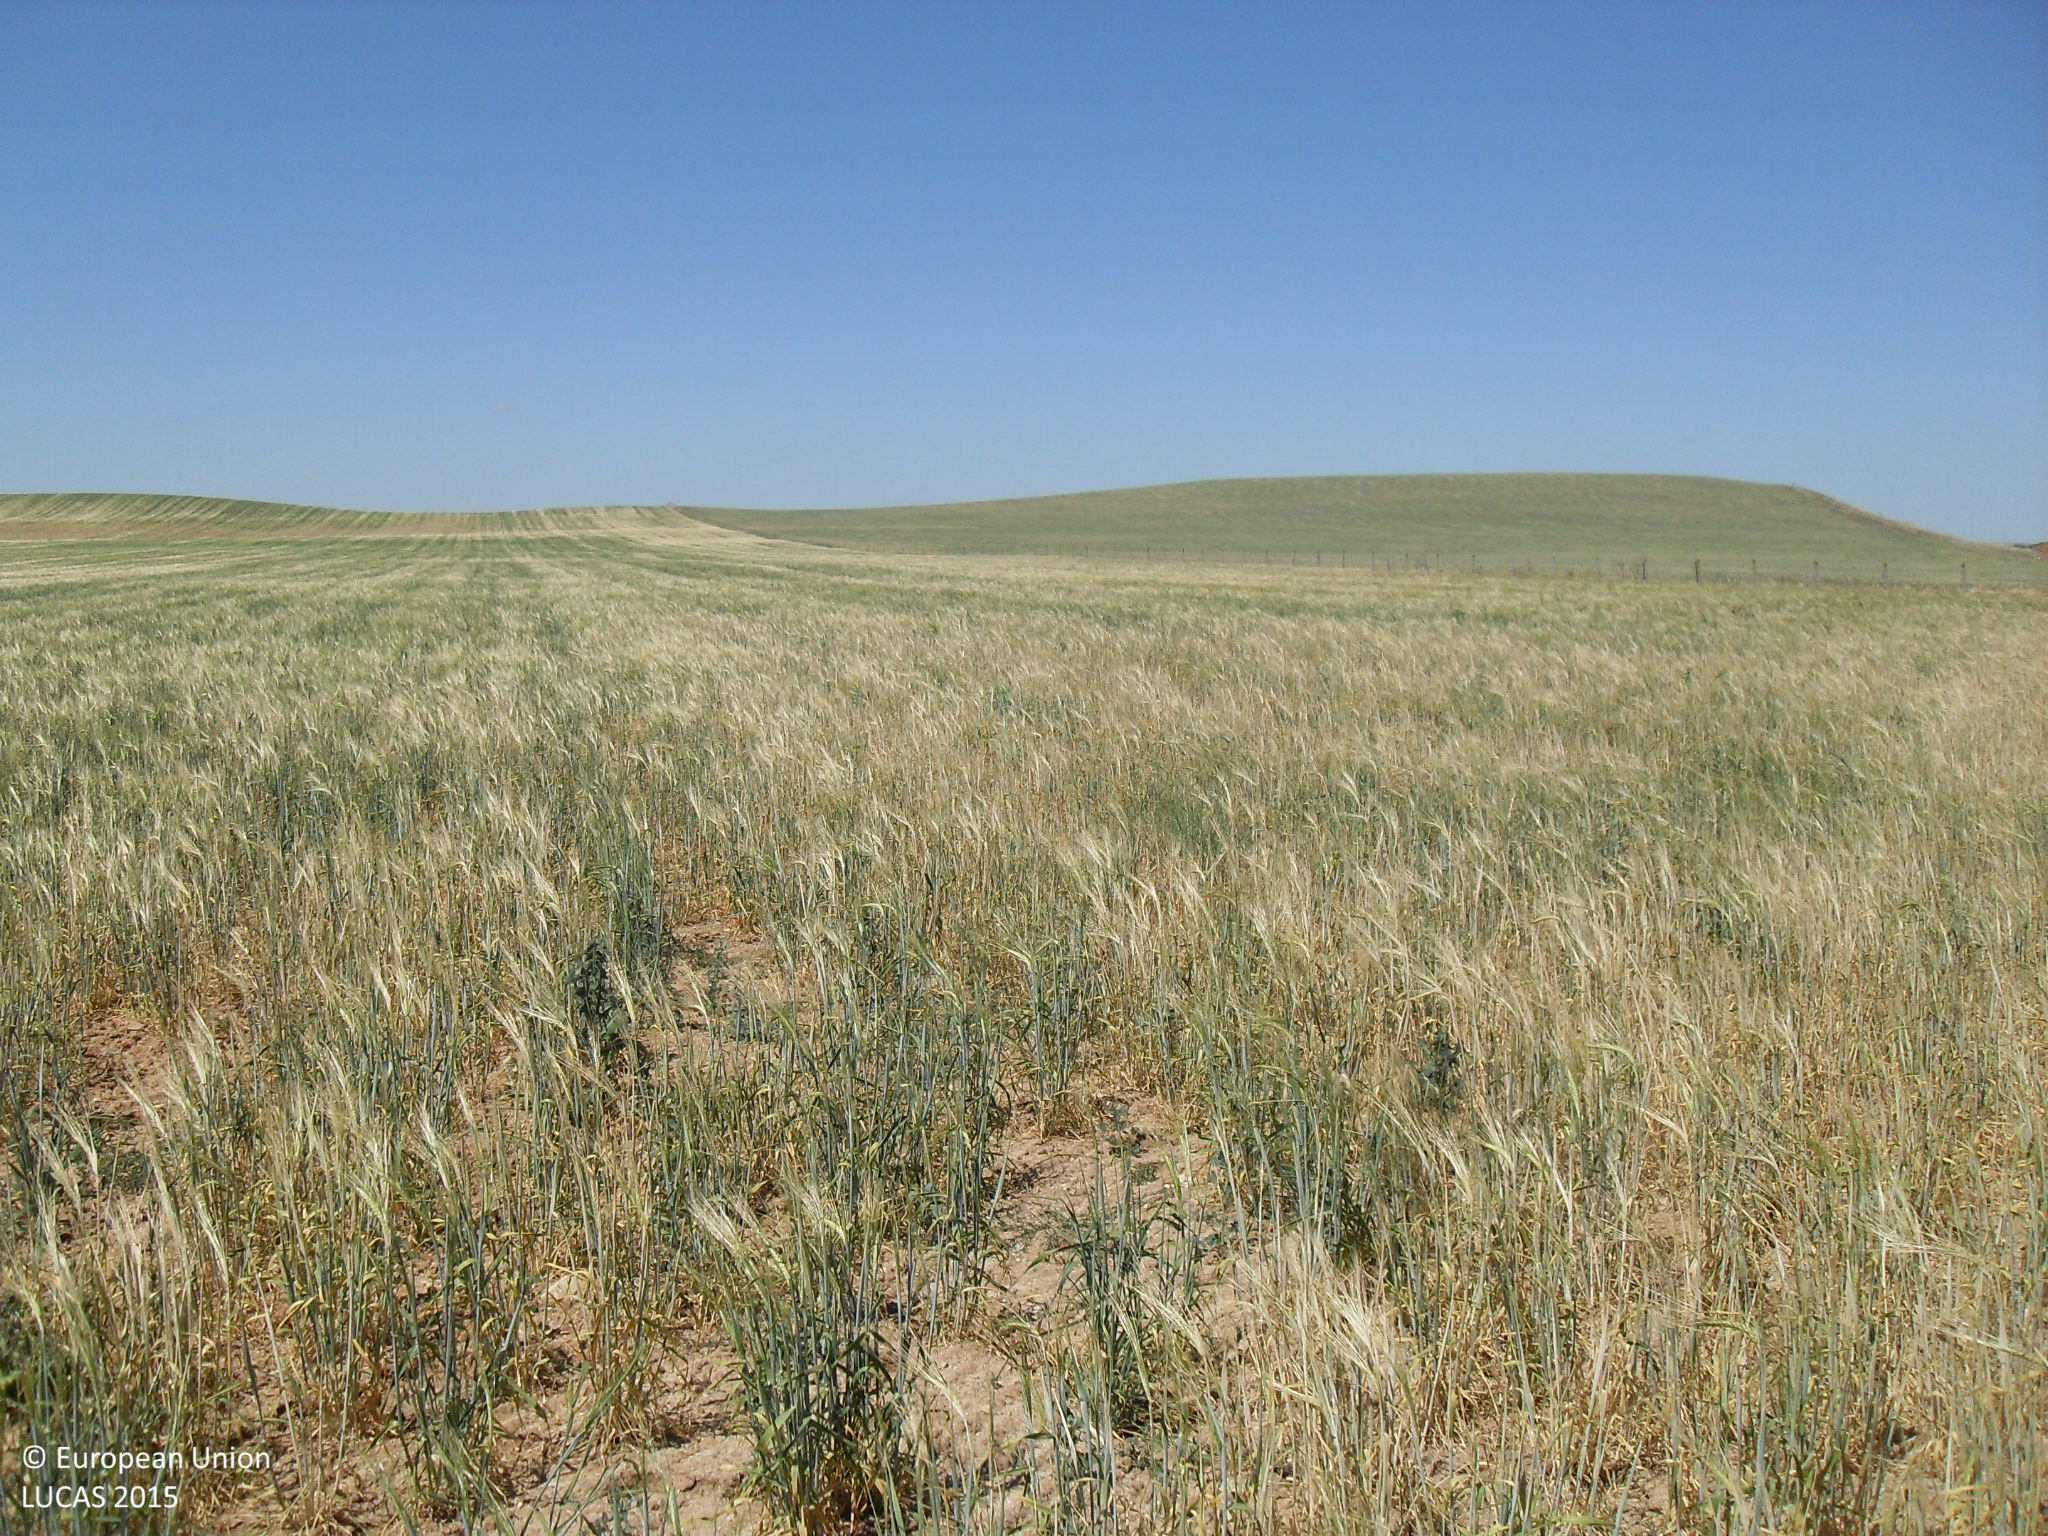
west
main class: Cropland
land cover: Barley
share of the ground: > 75 %
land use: Agriculture (excluding fallow land and kitchen gardens)
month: May
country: ES
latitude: 41.1231
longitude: -5.2578
